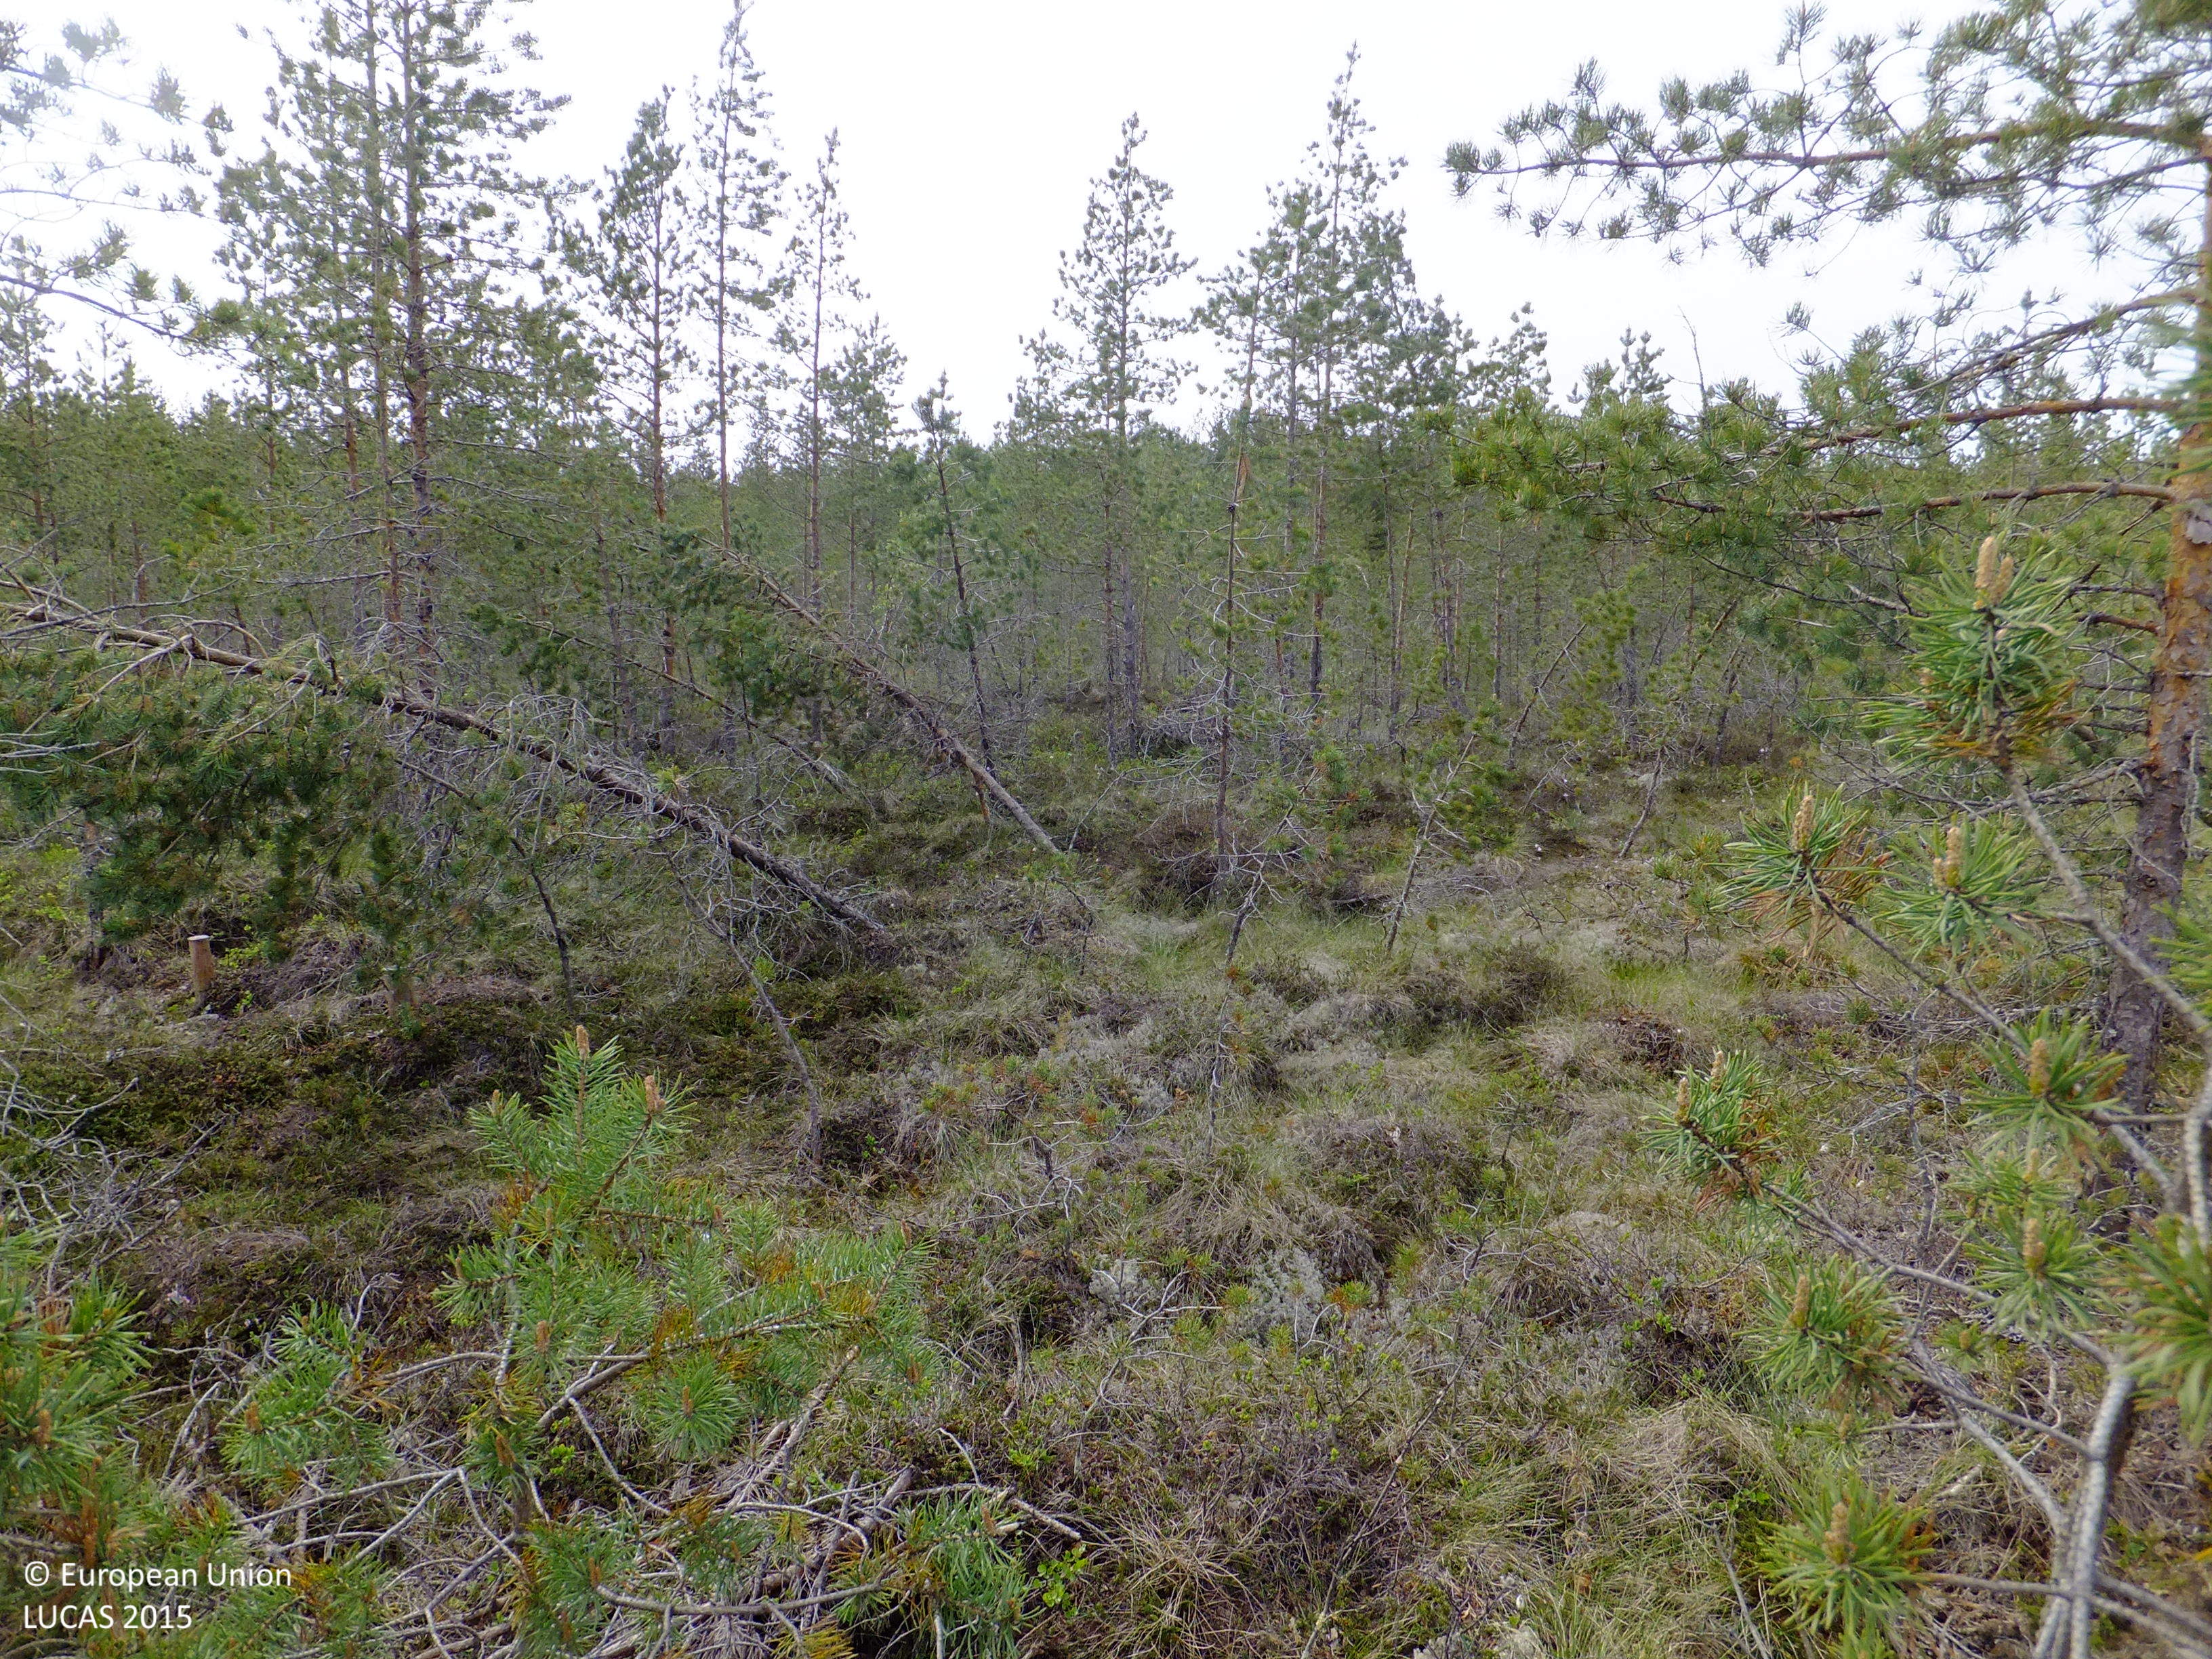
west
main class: Woodland
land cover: Pine dominated coniferous woodland
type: mire and swamp forests
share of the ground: > 75 %
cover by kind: coniferous forest trees 75 %, herbaceous plants 15 %, lichens and mosses 10 %
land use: Forestry
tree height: > 5 m
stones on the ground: < 10 %
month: June
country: FI
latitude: 63.4534
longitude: 22.8273
